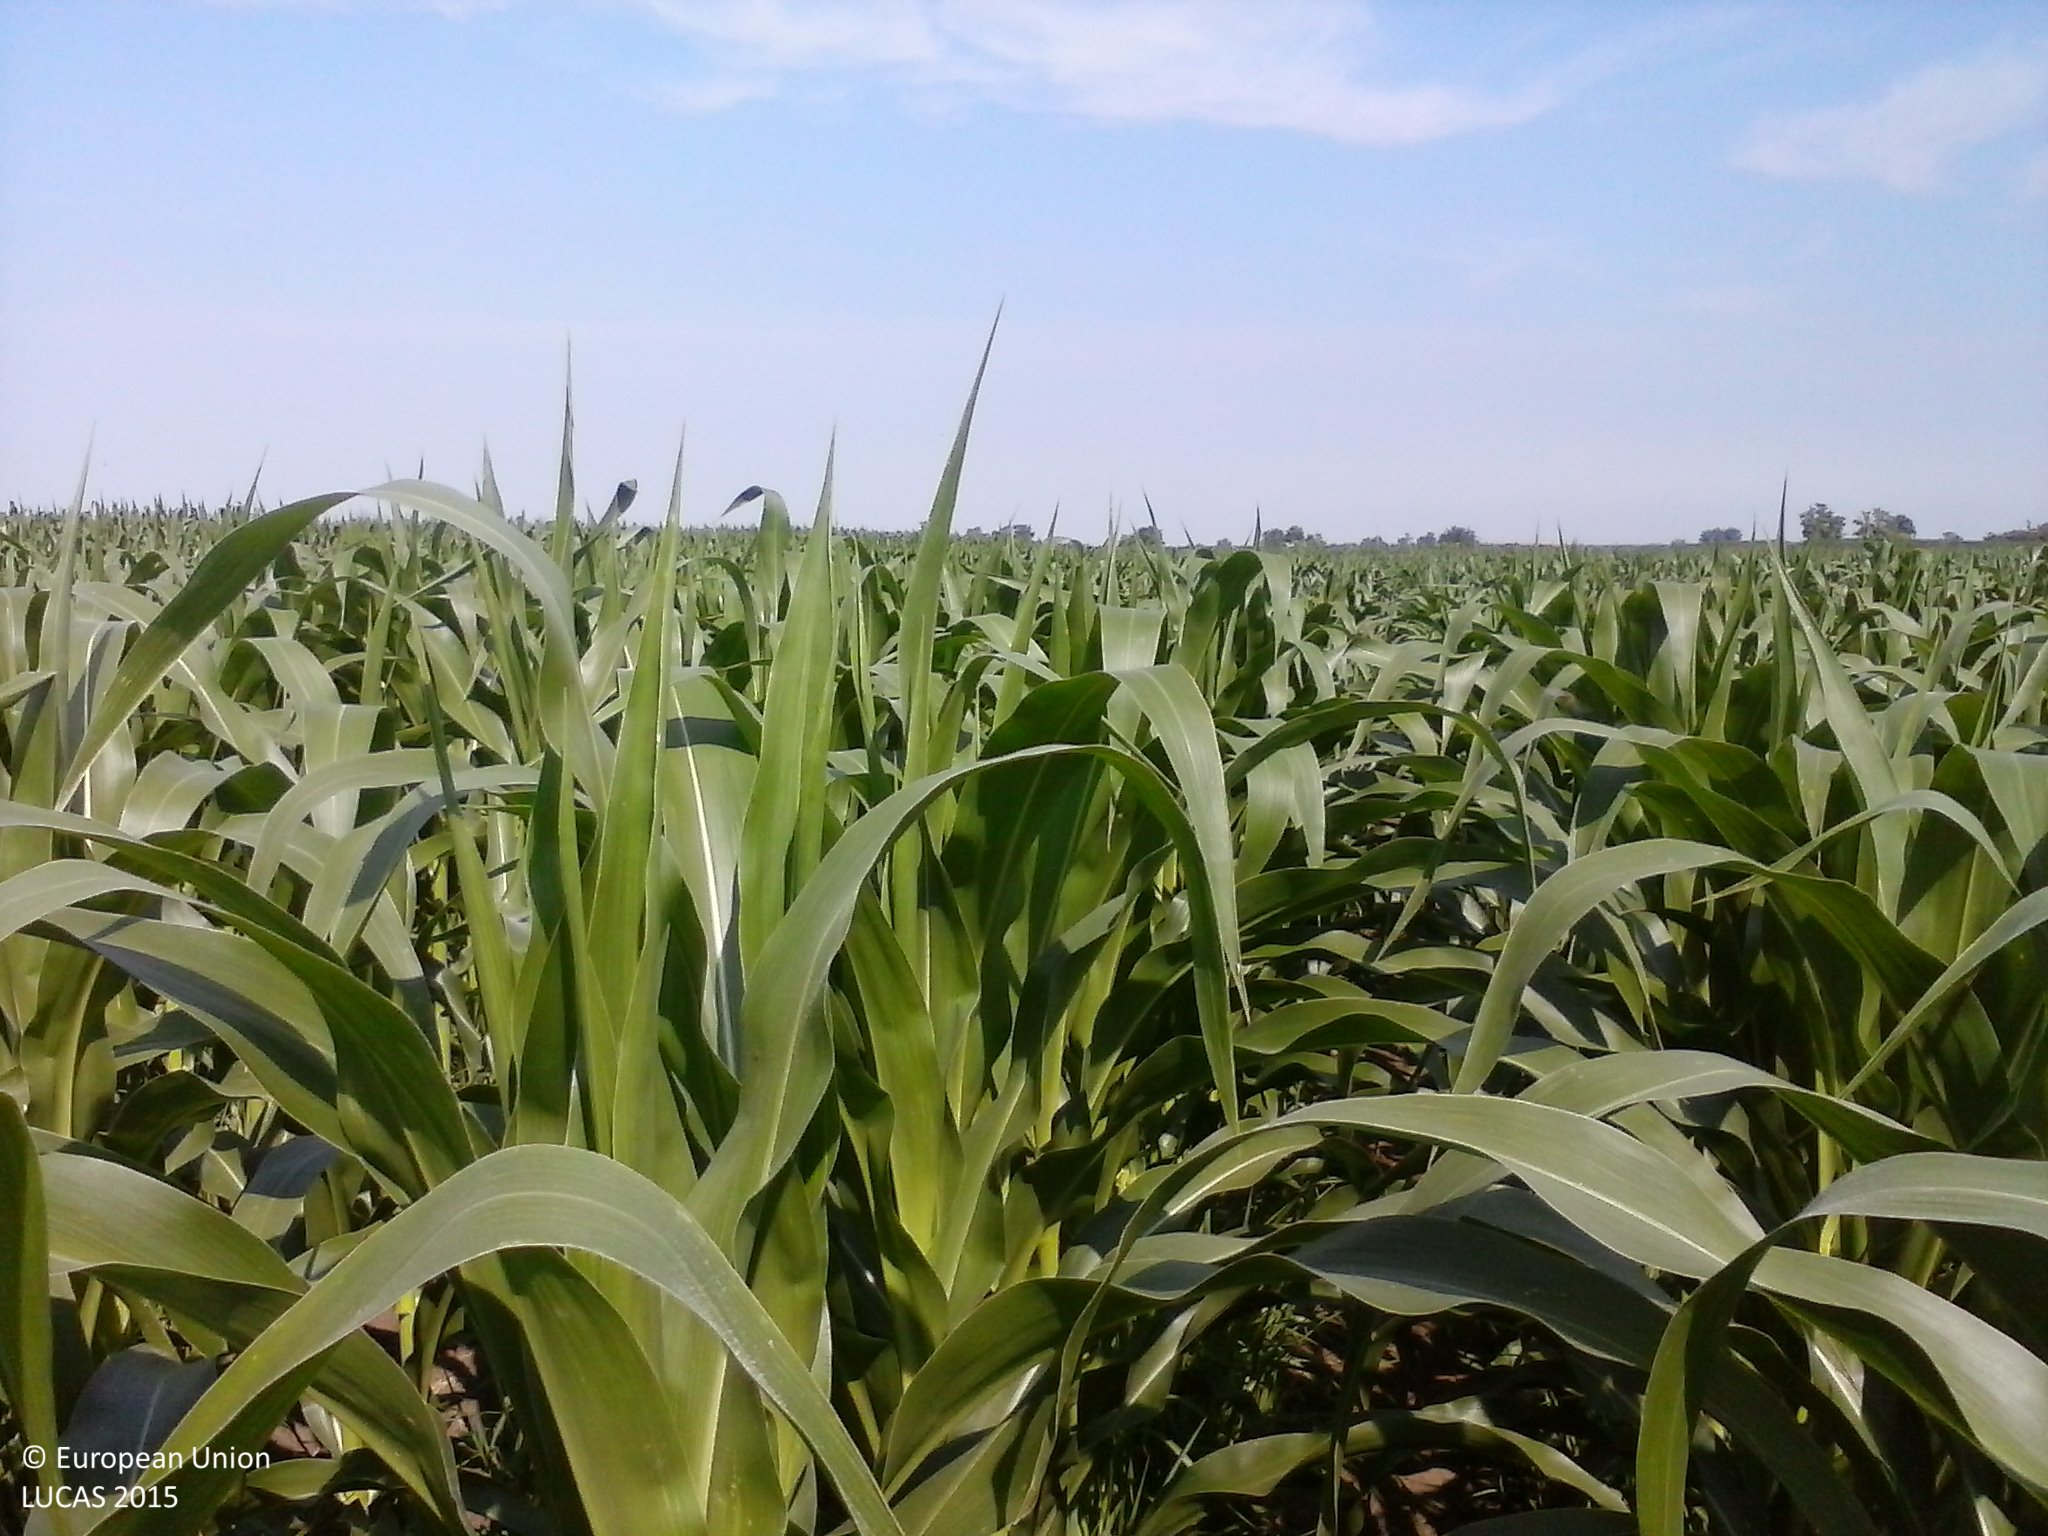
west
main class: Cropland
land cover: Maize
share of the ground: > 75 %
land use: Agriculture (excluding fallow land and kitchen gardens)
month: June
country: HU
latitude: 46.1624
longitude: 19.5087
